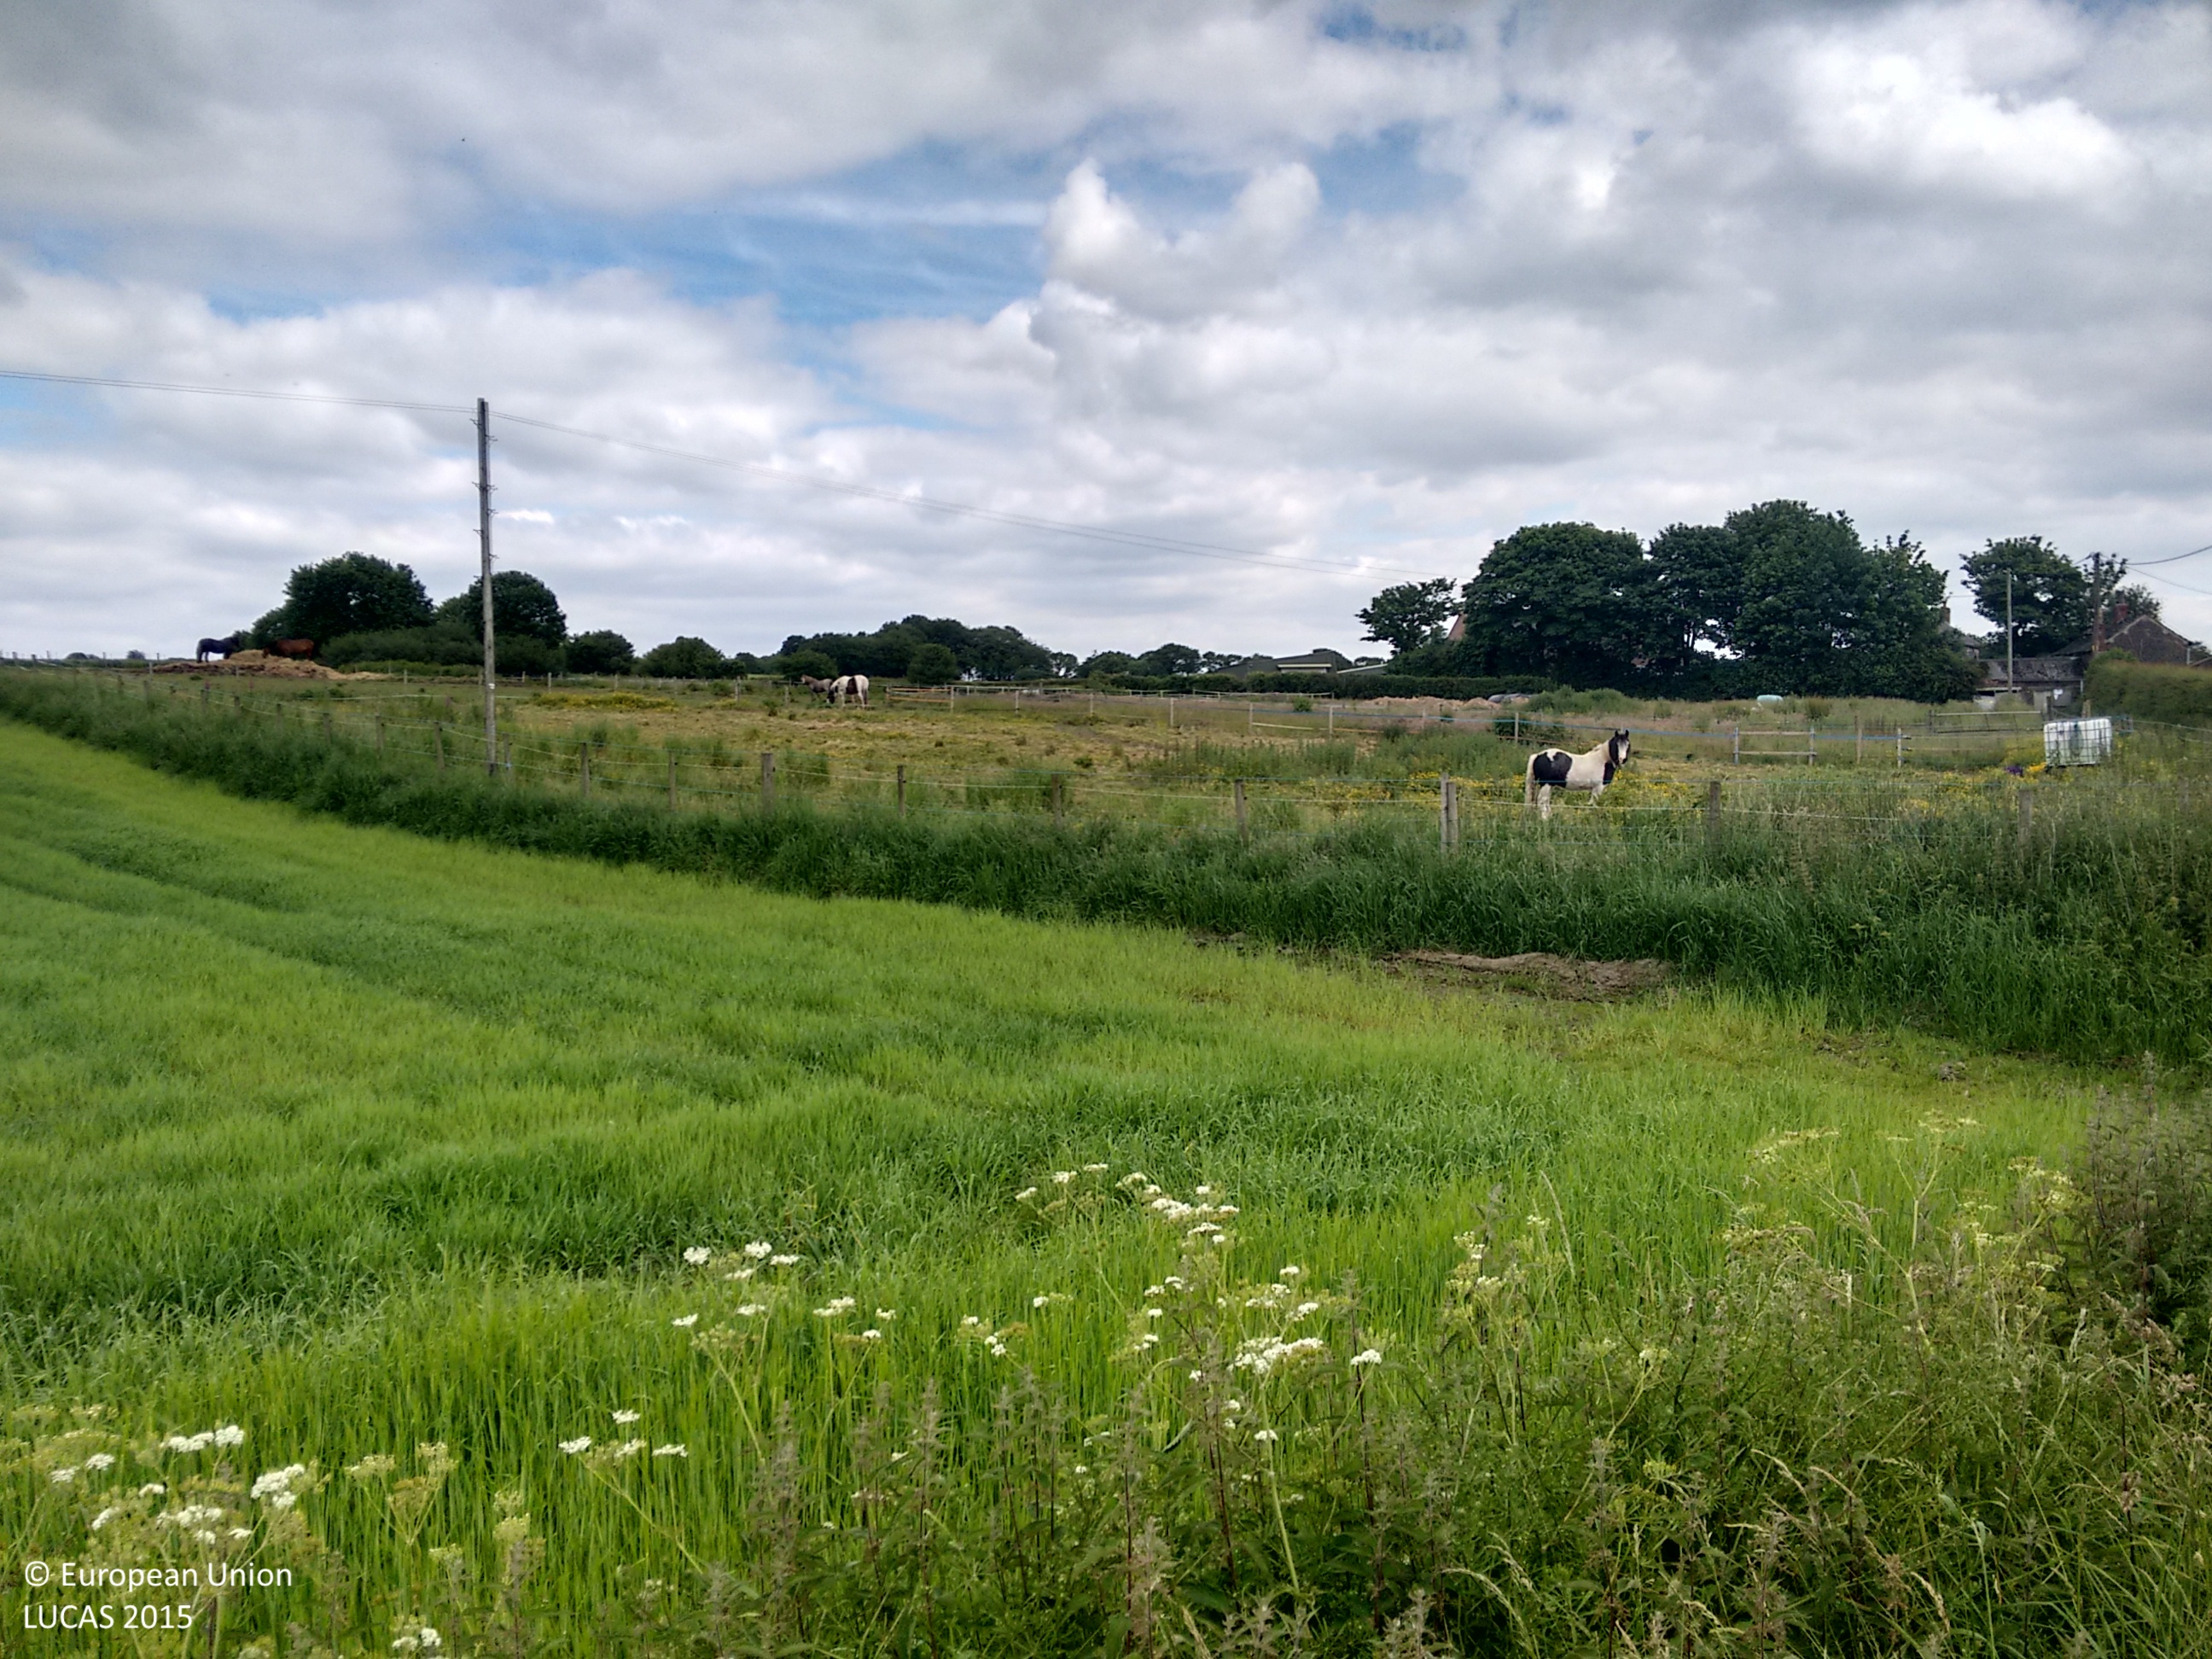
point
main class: Grassland
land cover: Grassland without tree/shrub cover
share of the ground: > 75 %
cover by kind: herbaceous plants 100 %
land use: Agriculture (excluding fallow land and kitchen gardens)
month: June
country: GB
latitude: 53.5648
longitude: -2.5527
